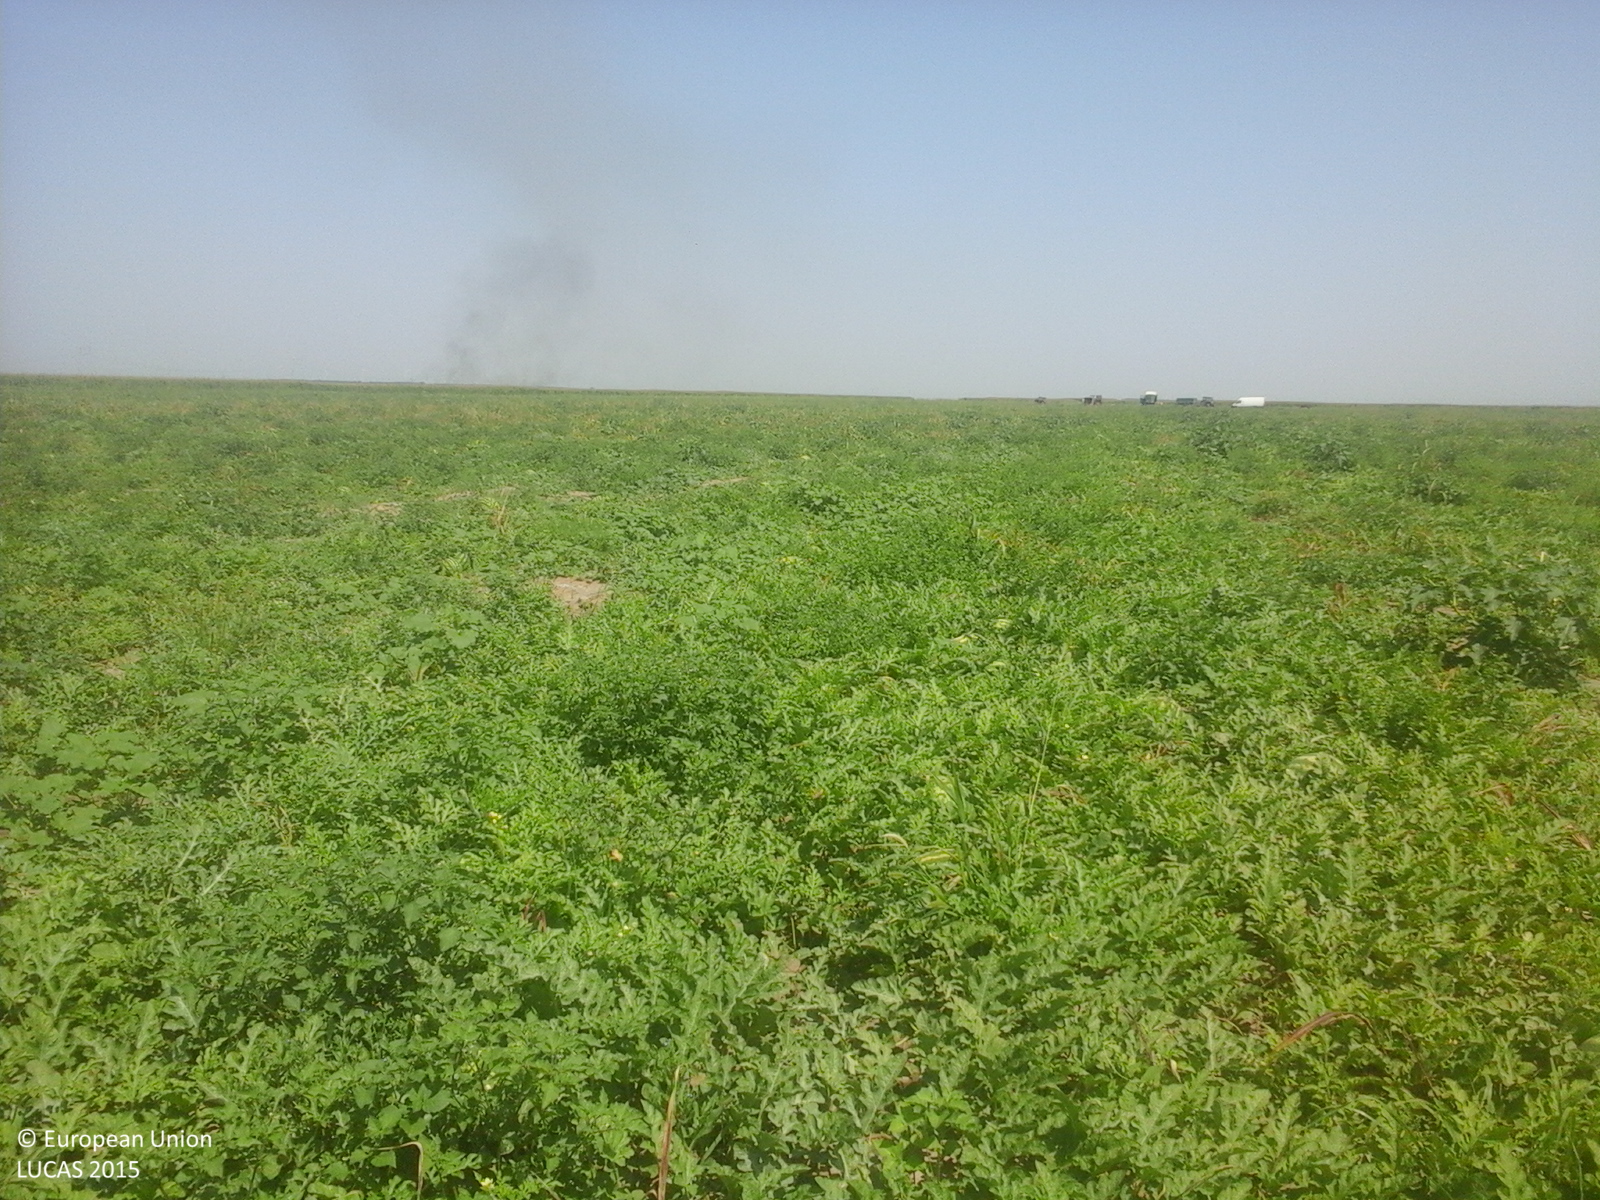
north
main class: Cropland
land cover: Other fresh vegetables
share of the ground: > 75 %
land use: Agriculture (excluding fallow land and kitchen gardens)
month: July
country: RO
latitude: 44.7891
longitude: 27.6826
